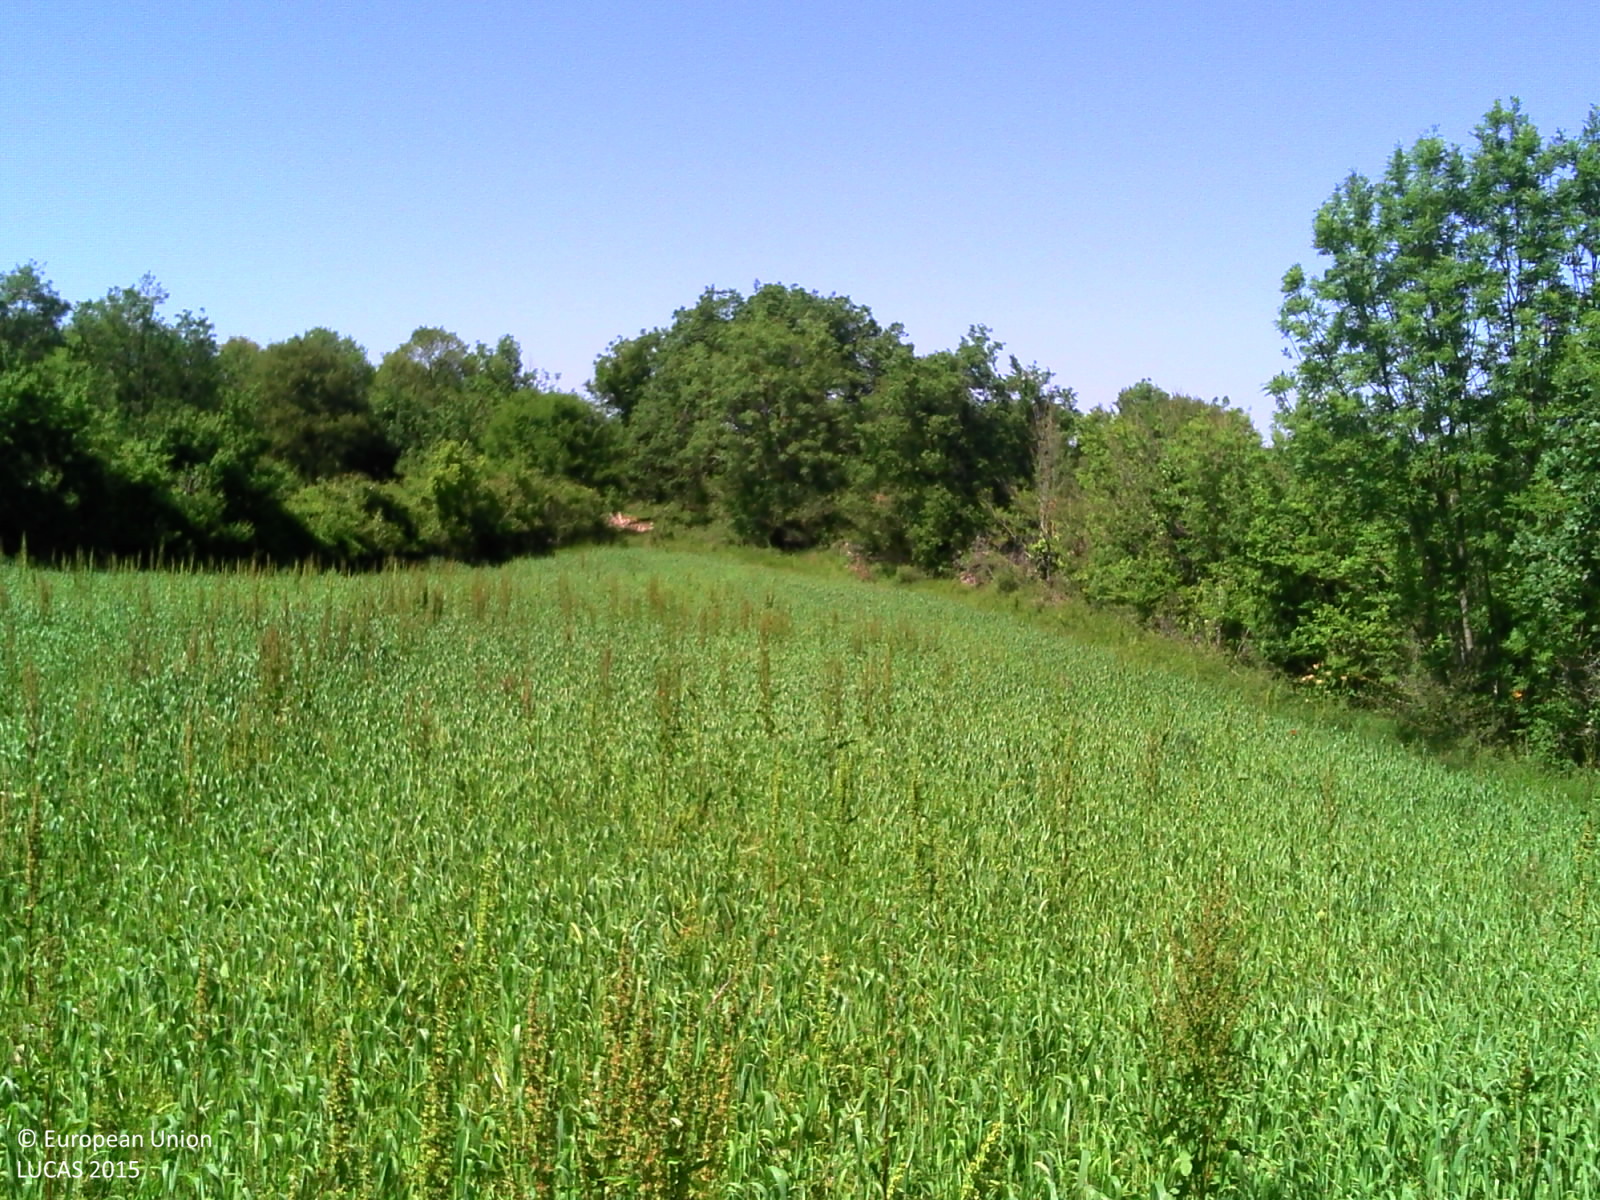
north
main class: Cropland
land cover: Barley
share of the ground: > 75 %
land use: Agriculture (excluding fallow land and kitchen gardens)
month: May
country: FR
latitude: 44.5394
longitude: 1.8822
